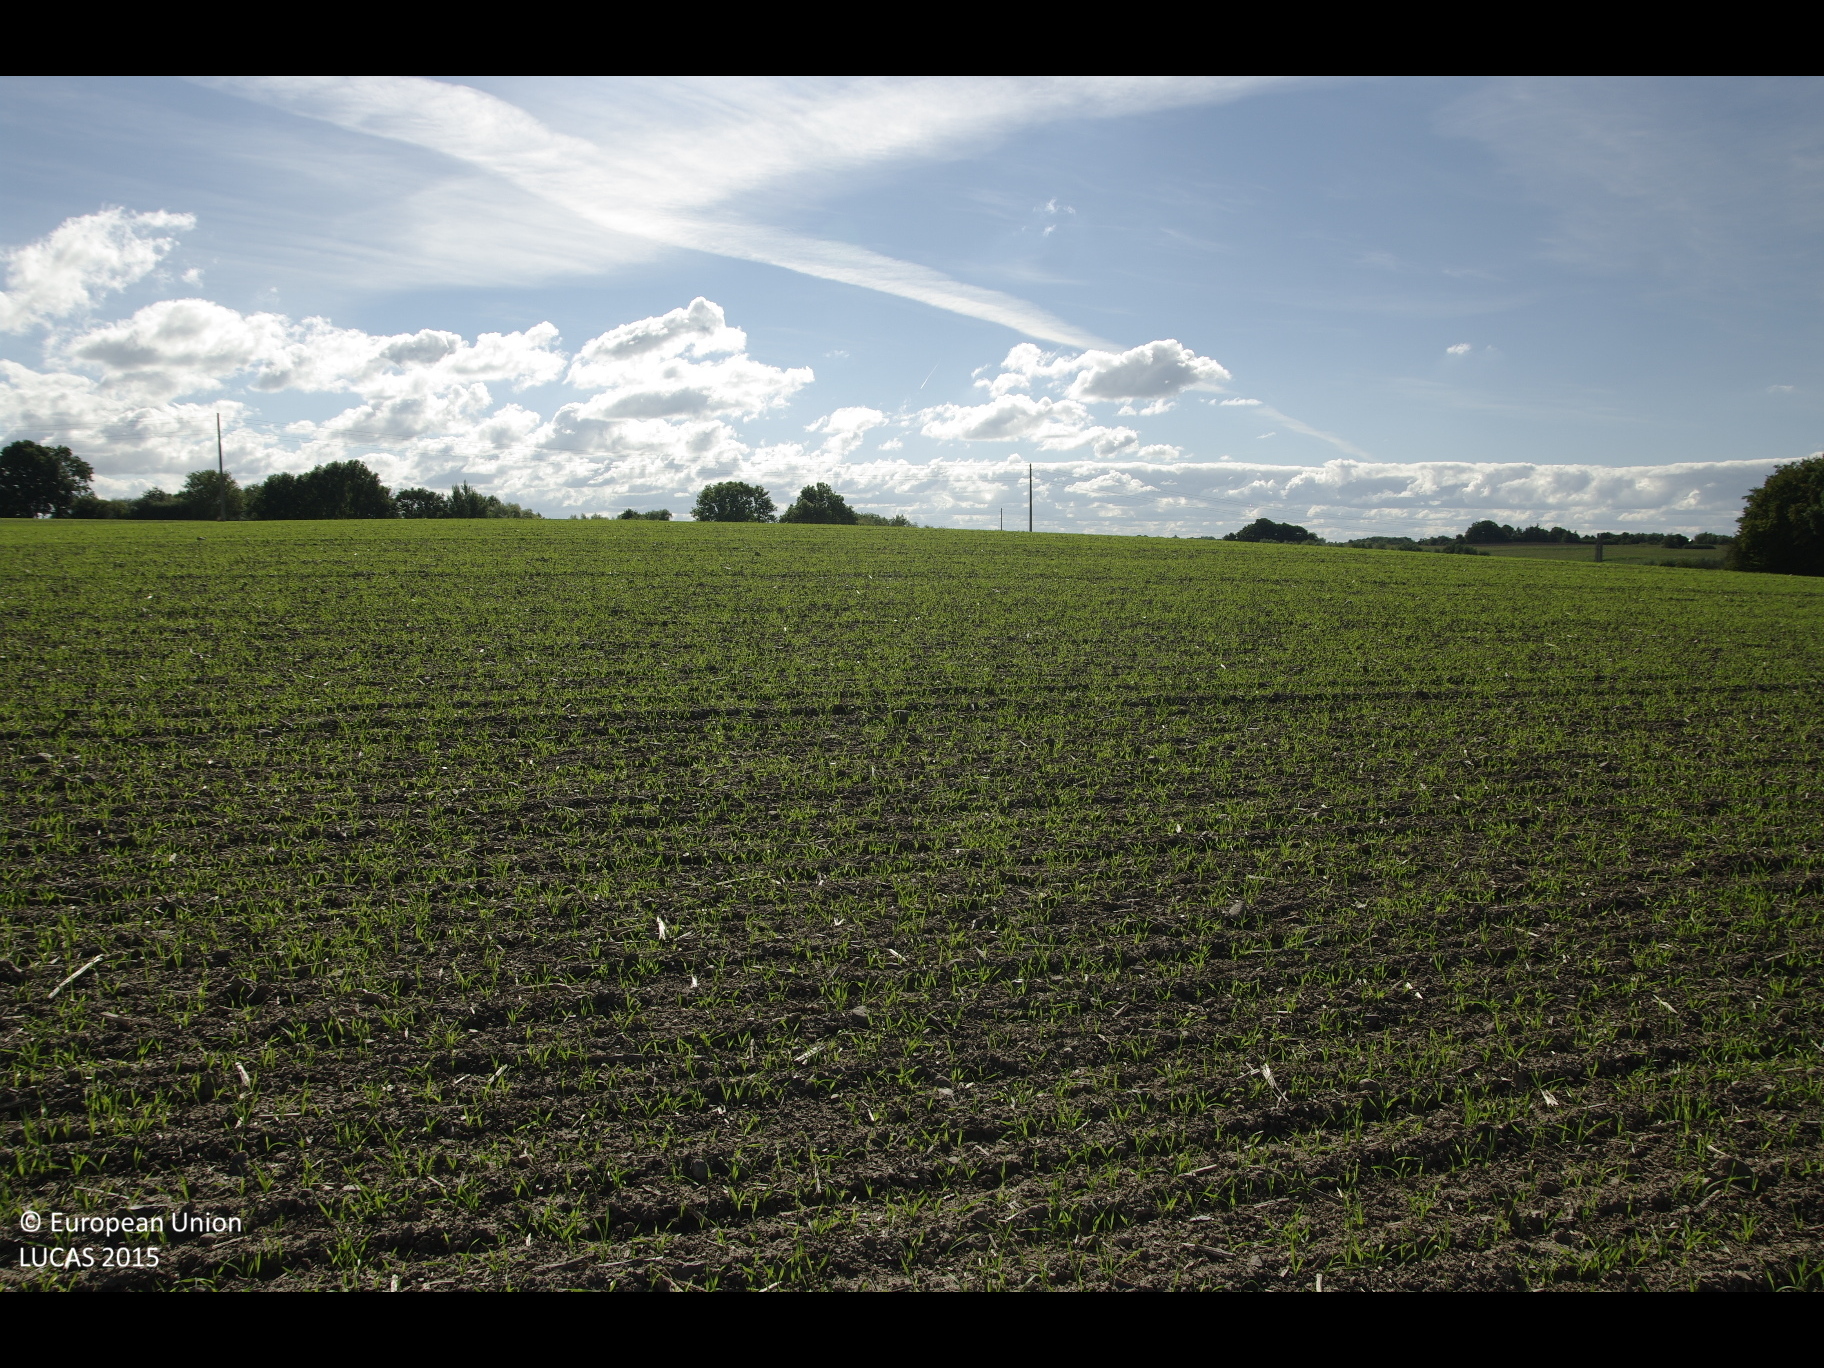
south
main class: Cropland
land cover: Rape and turnip rape
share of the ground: < 10 %
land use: Agriculture (excluding fallow land and kitchen gardens)
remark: Harvested field
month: September
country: DE
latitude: 53.9178
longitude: 11.1413
